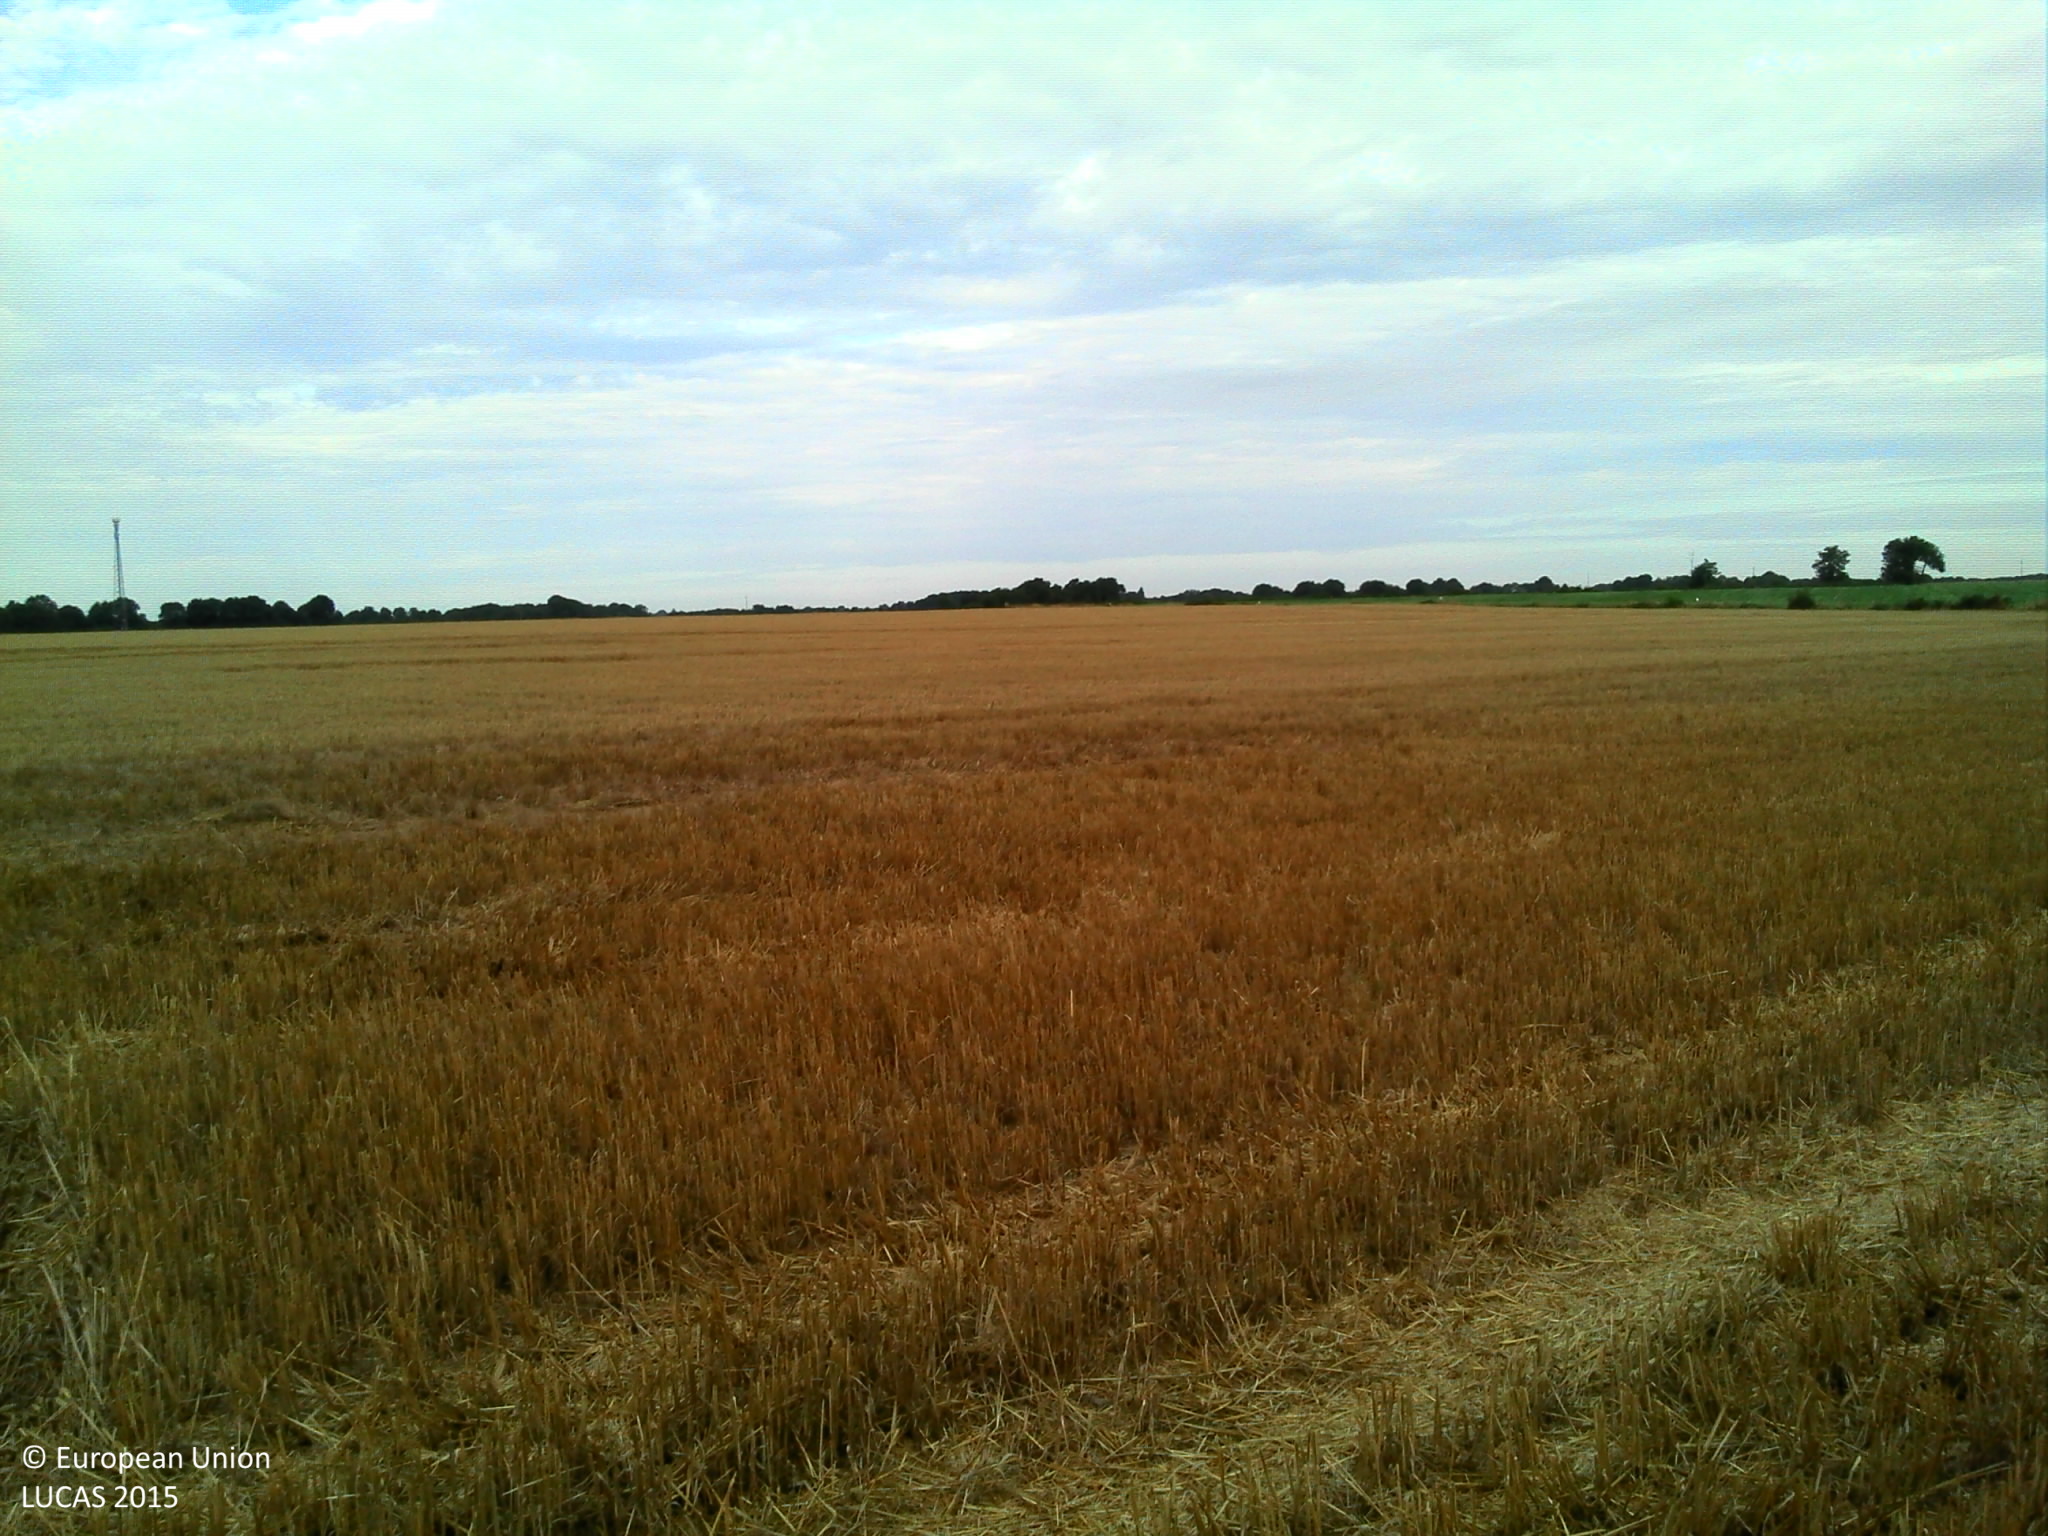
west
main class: Cropland
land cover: Common wheat
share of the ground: > 75 %
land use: Agriculture (excluding fallow land and kitchen gardens)
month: July
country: FR
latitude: 46.4982
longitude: 0.1946
